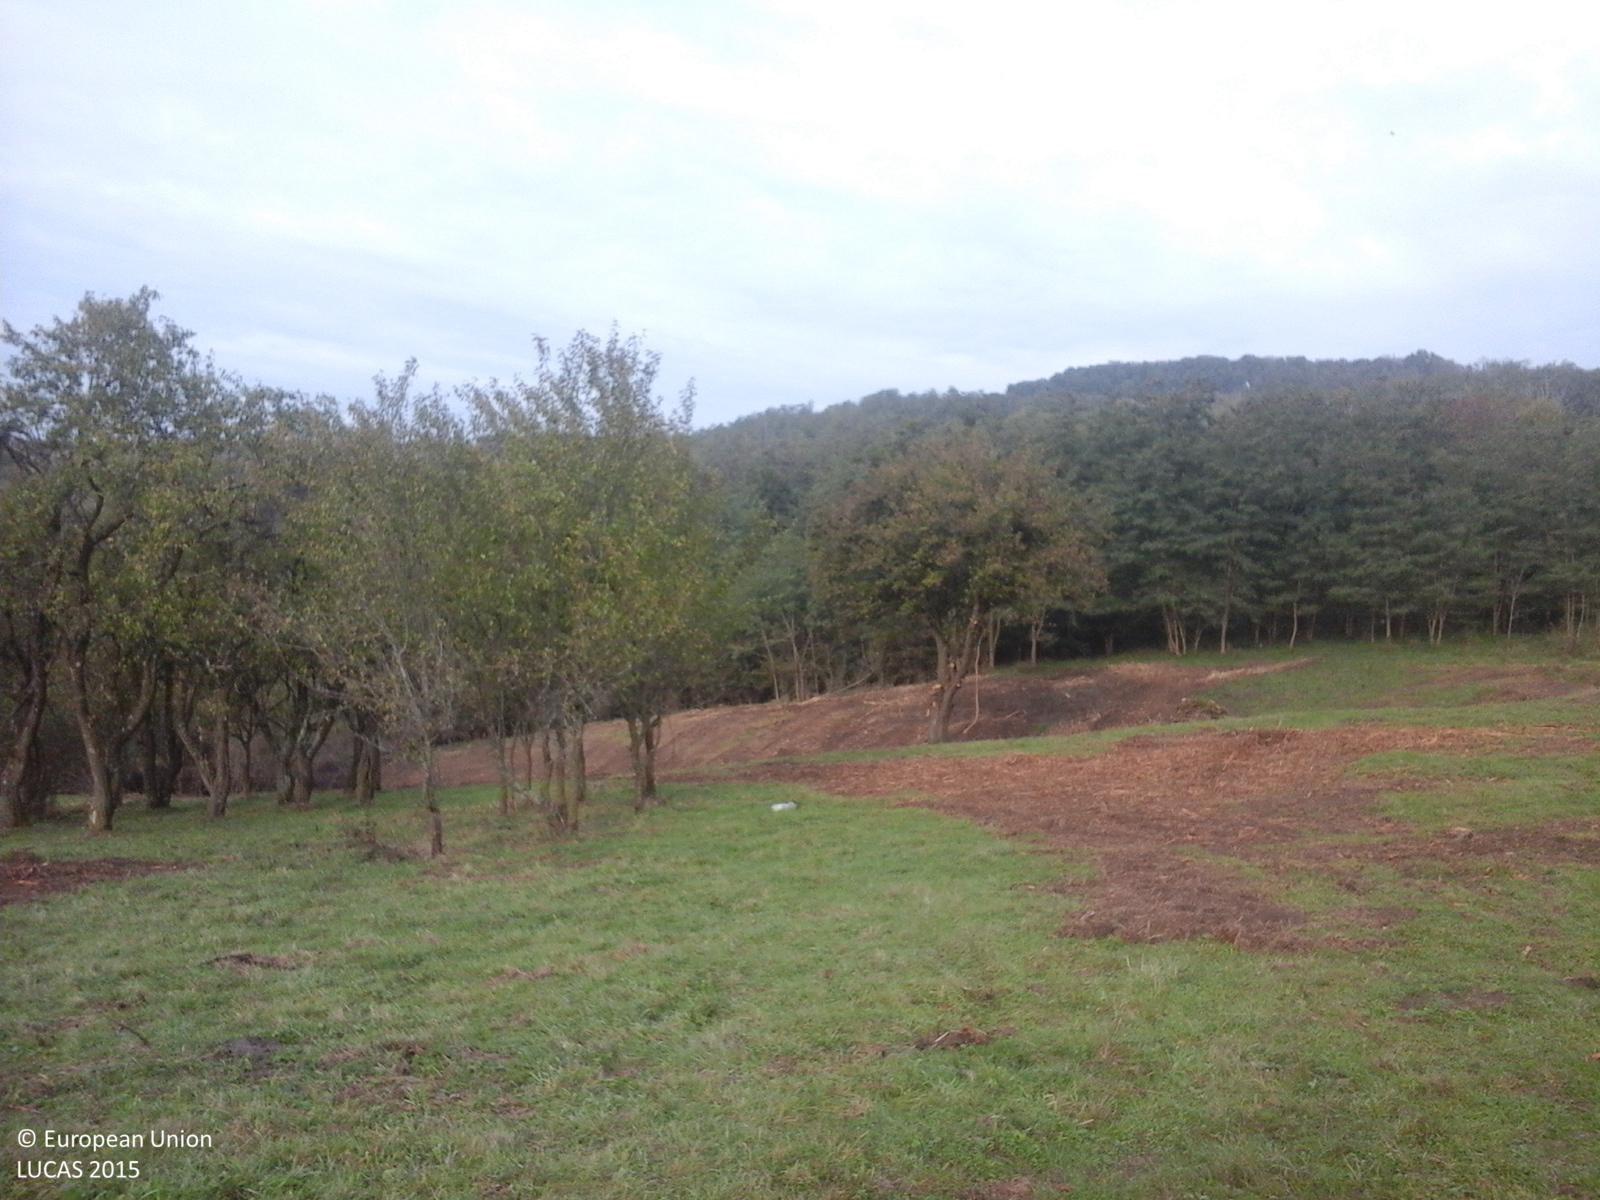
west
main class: Grassland
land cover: Grassland without tree/shrub cover
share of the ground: > 75 %
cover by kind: herbaceous plants 100 %
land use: Agriculture (excluding fallow land and kitchen gardens)
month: October
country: RO
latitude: 45.8304
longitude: 24.7759
